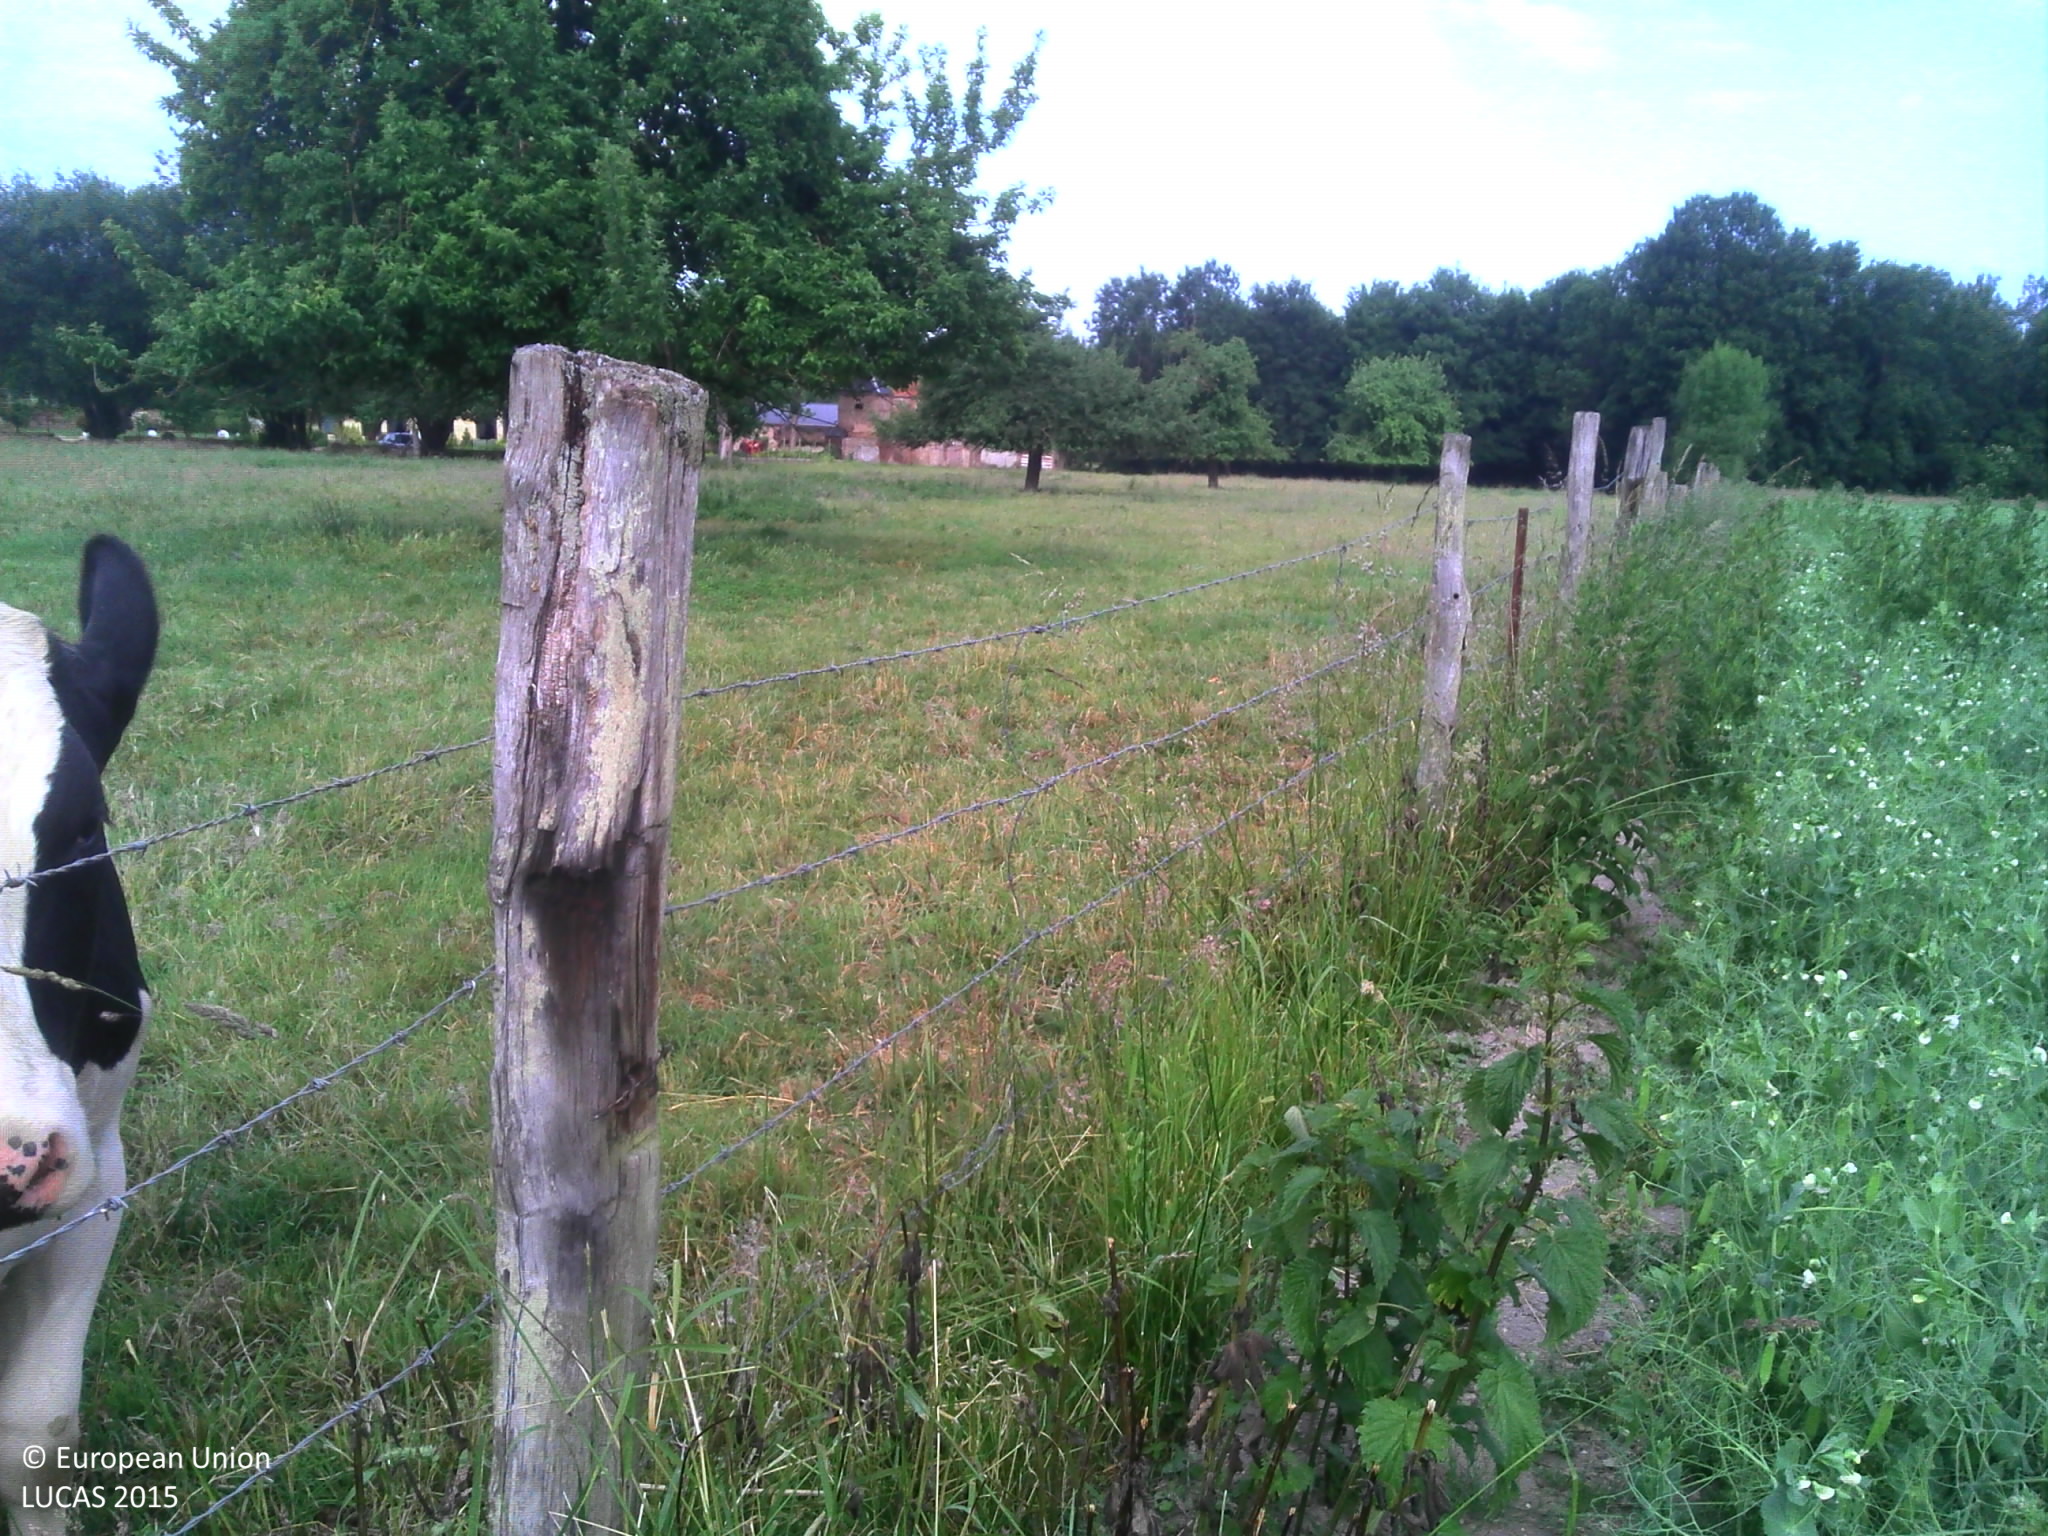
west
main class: Grassland
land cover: Grassland with sparse tree/shrub cover
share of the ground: > 75 %
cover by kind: herbaceous plants 95 %, broadleaved forest trees 5 %
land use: Agriculture (excluding fallow land and kitchen gardens)
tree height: > 5 m
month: June
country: FR
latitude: 49.7655
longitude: 2.3650
